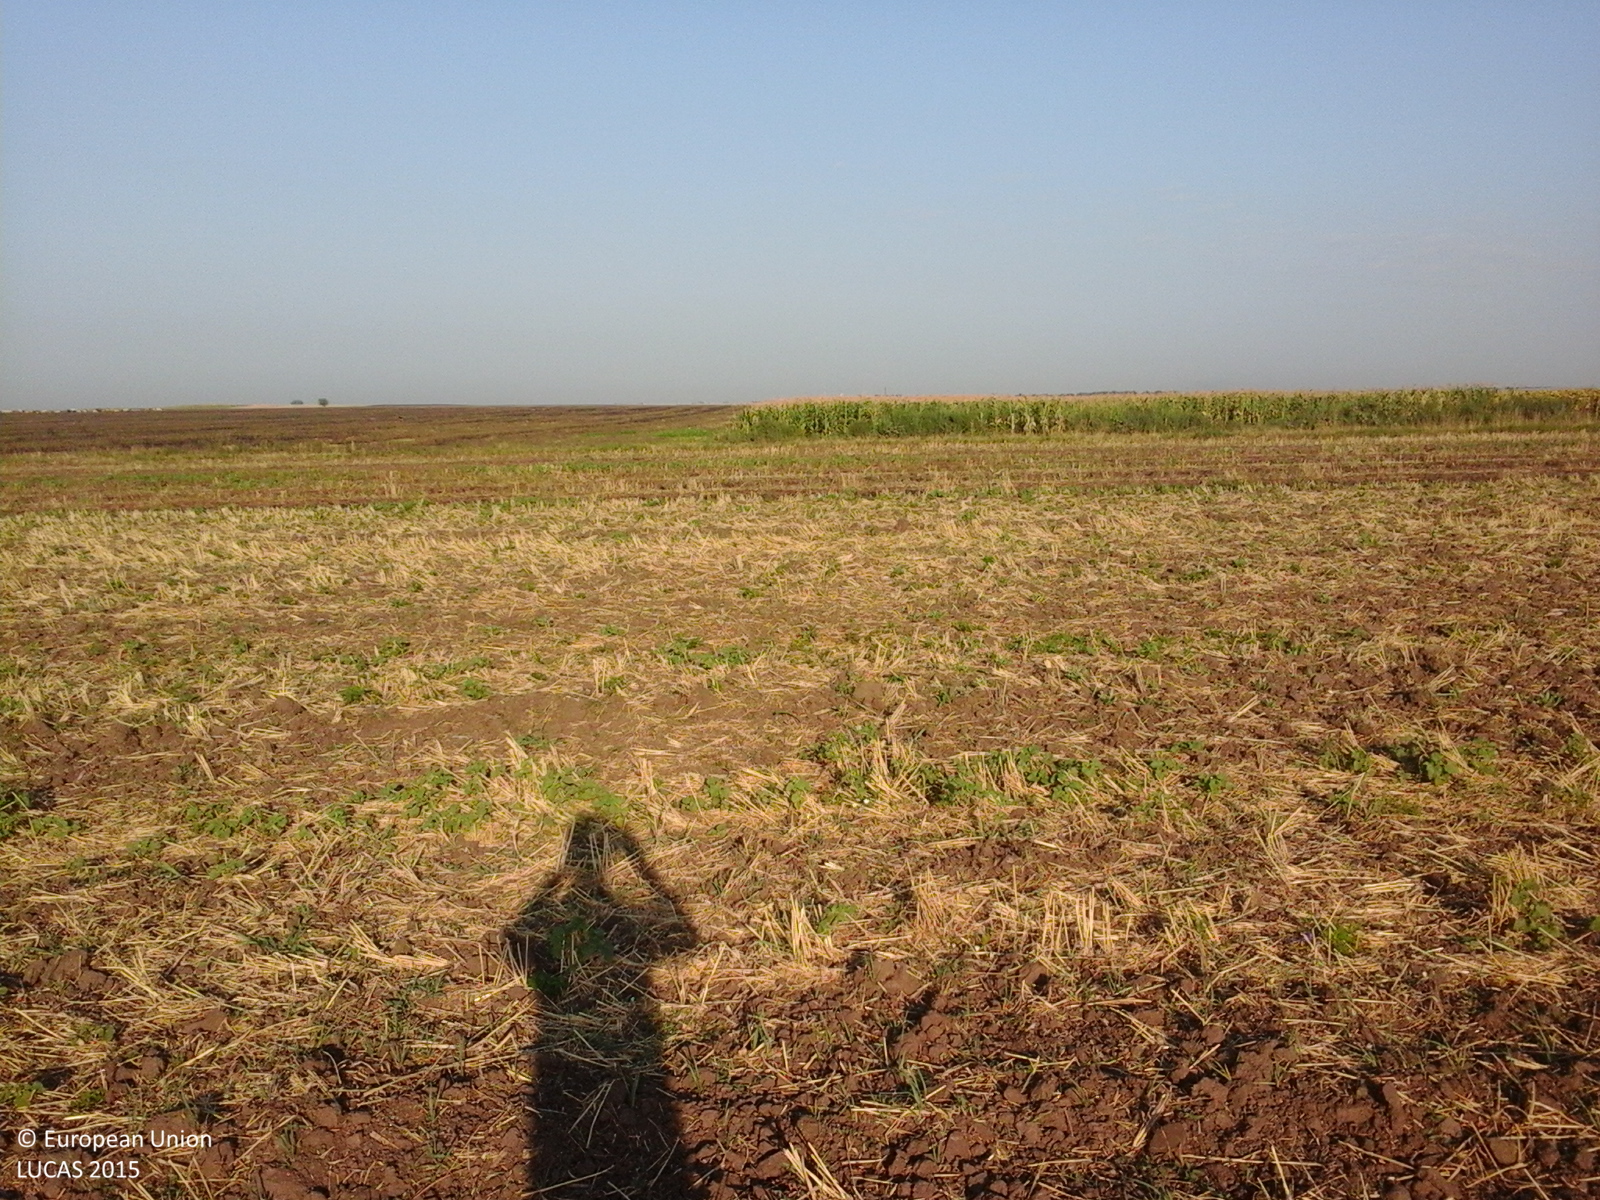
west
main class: Cropland
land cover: Common wheat
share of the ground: 50 - 75 %
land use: Agriculture (excluding fallow land and kitchen gardens)
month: August
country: RO
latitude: 44.0783
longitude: 23.2702
